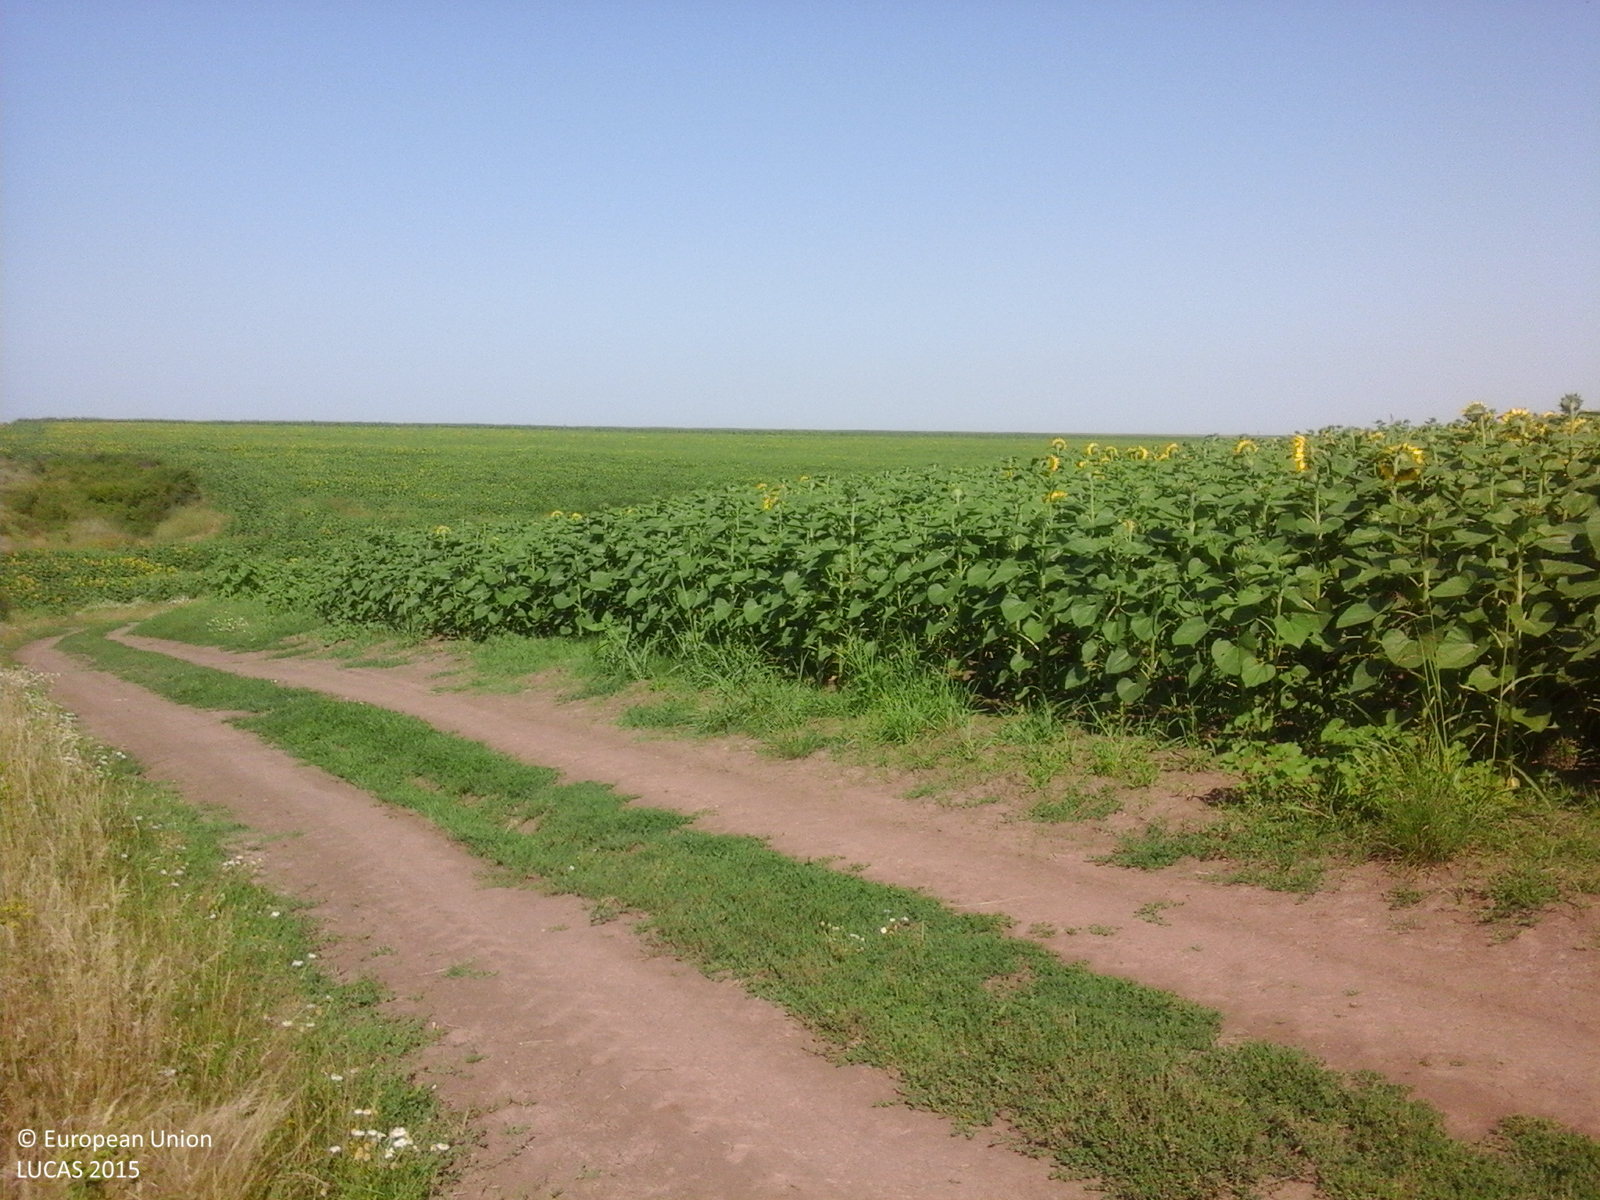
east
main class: Cropland
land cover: Sunflower
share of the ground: > 75 %
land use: Agriculture (excluding fallow land and kitchen gardens)
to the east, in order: Sunflower; Maize; Grassland without tree/shrub cover; Maize; Sunflower; Maize; Sunflower
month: July
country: RO
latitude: 44.3918
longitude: 24.5967
